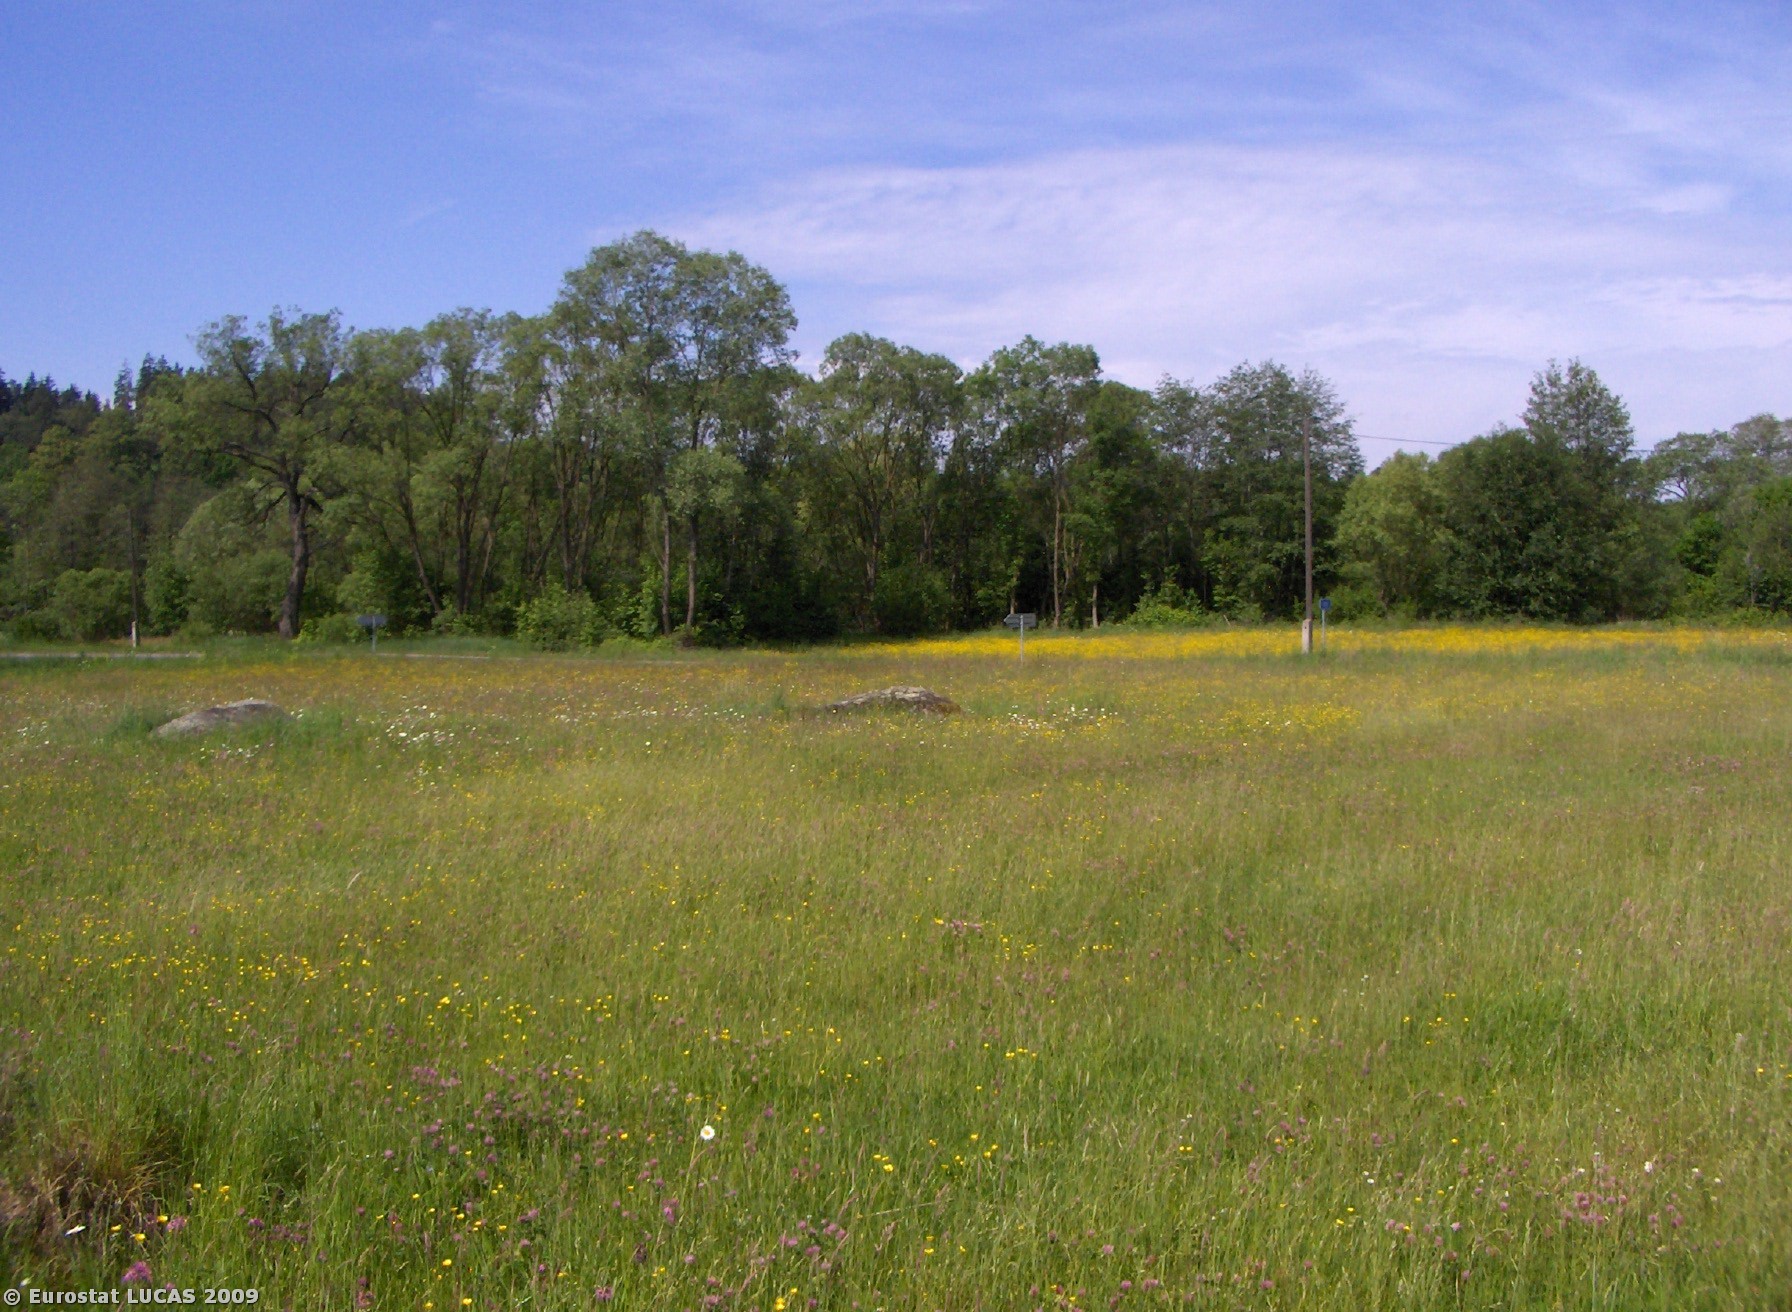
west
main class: Grassland
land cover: Grassland without tree/shrub cover
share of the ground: > 75 %
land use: Agriculture (excluding fallow land and kitchen gardens)
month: May
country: CZ
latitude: 49.5607
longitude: 14.3562
